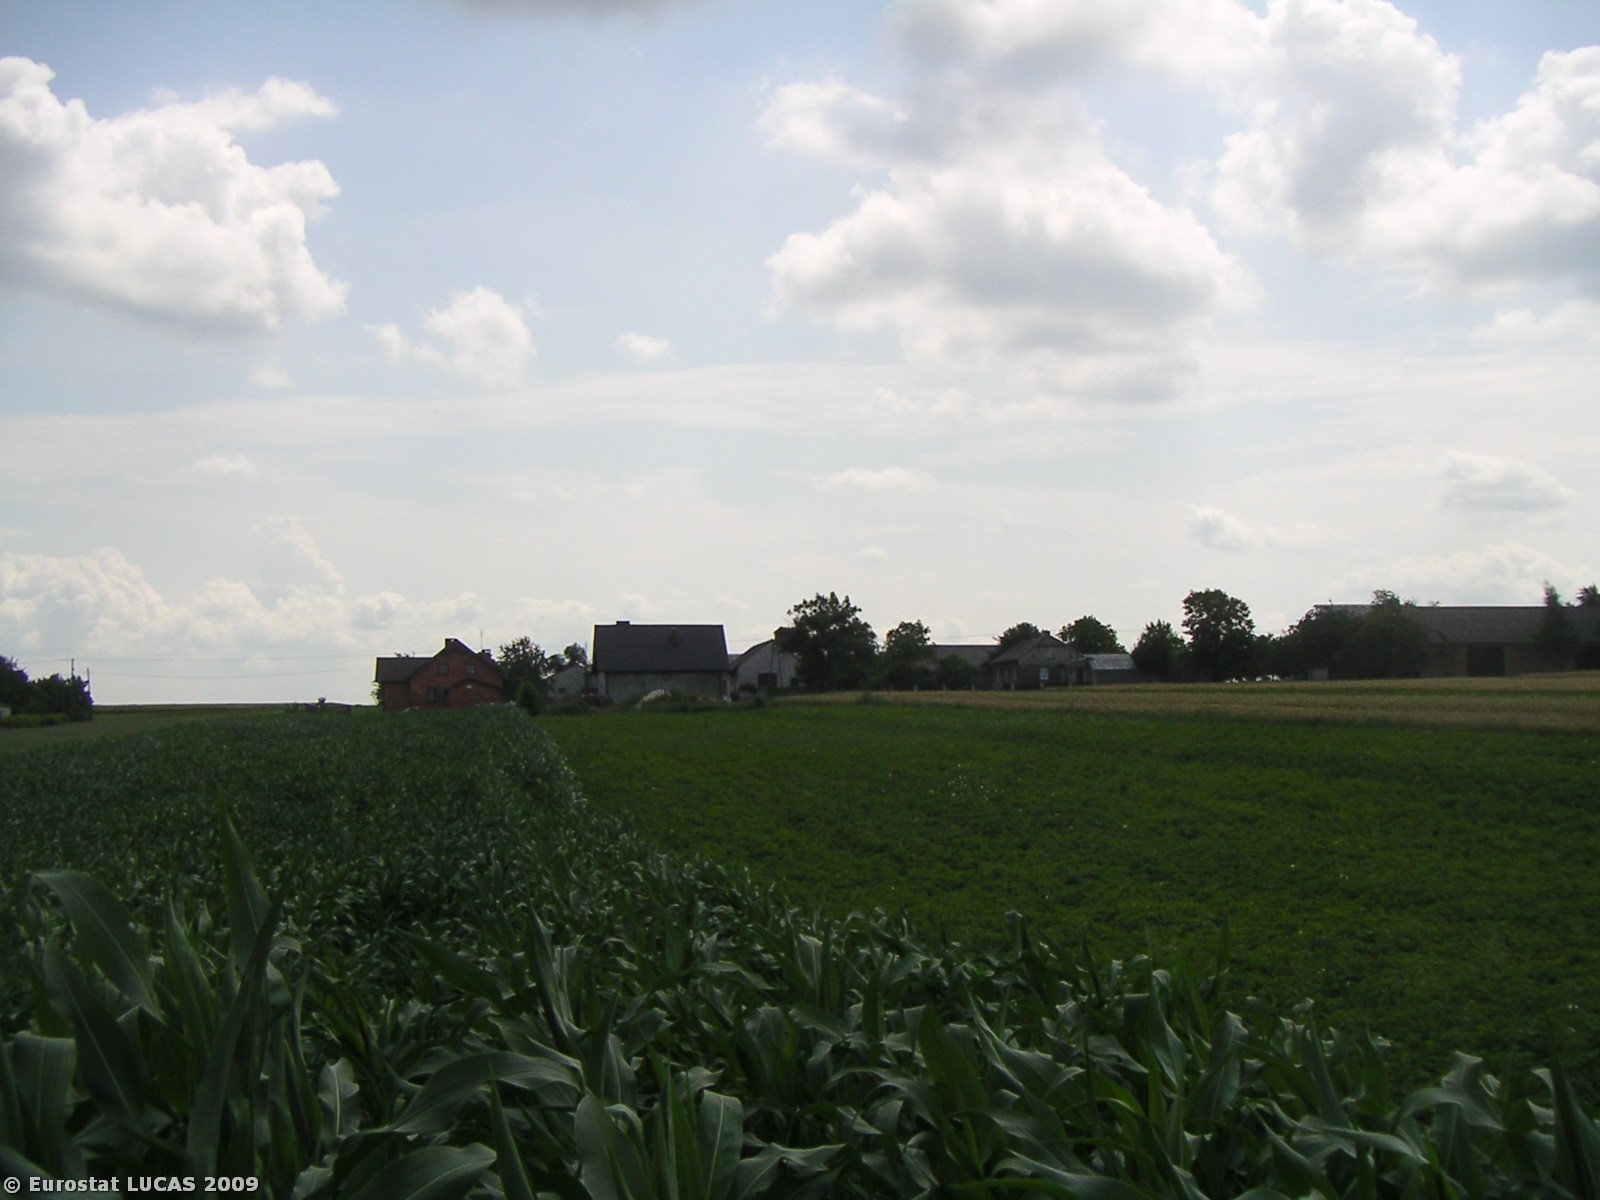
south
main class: Cropland
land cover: Maize
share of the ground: > 75 %
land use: Agriculture (excluding fallow land and kitchen gardens)
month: July
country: PL
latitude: 50.5085
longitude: 19.7455
